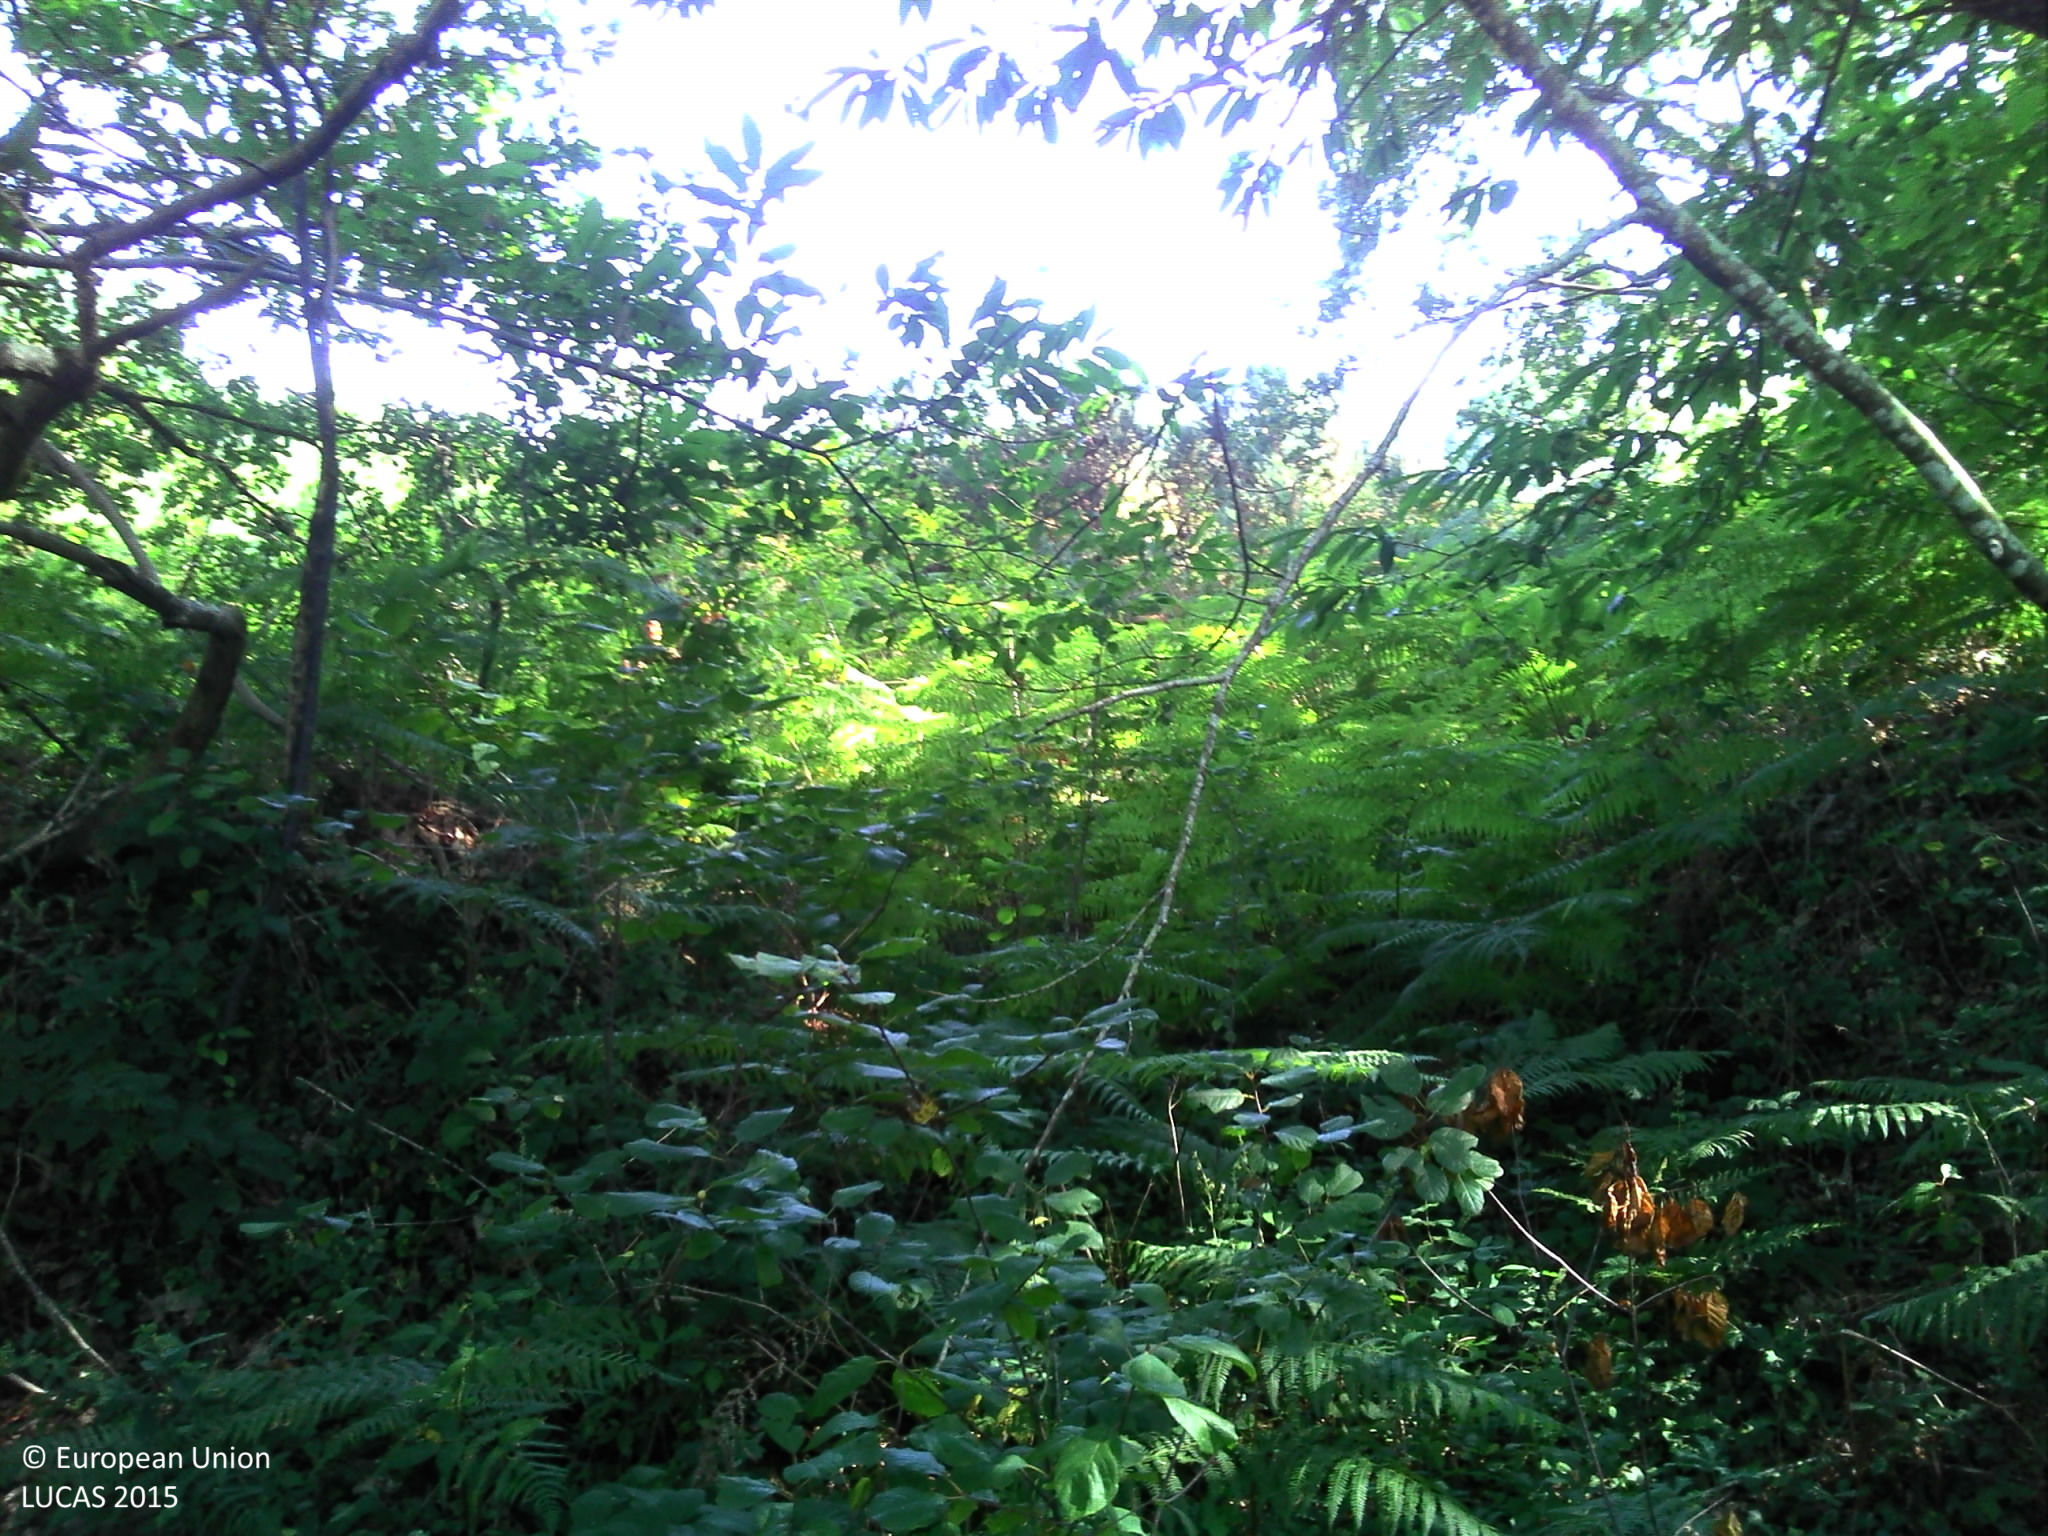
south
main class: Shrubland
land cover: Shrubland with sparse tree cover
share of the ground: > 75 %
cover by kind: shrubs 75 %, herbaceous plants 20 %, broadleaved forest trees 5 %
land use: Forestry
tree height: > 5 m
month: August
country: FR
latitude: 43.7152
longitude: -0.7740
